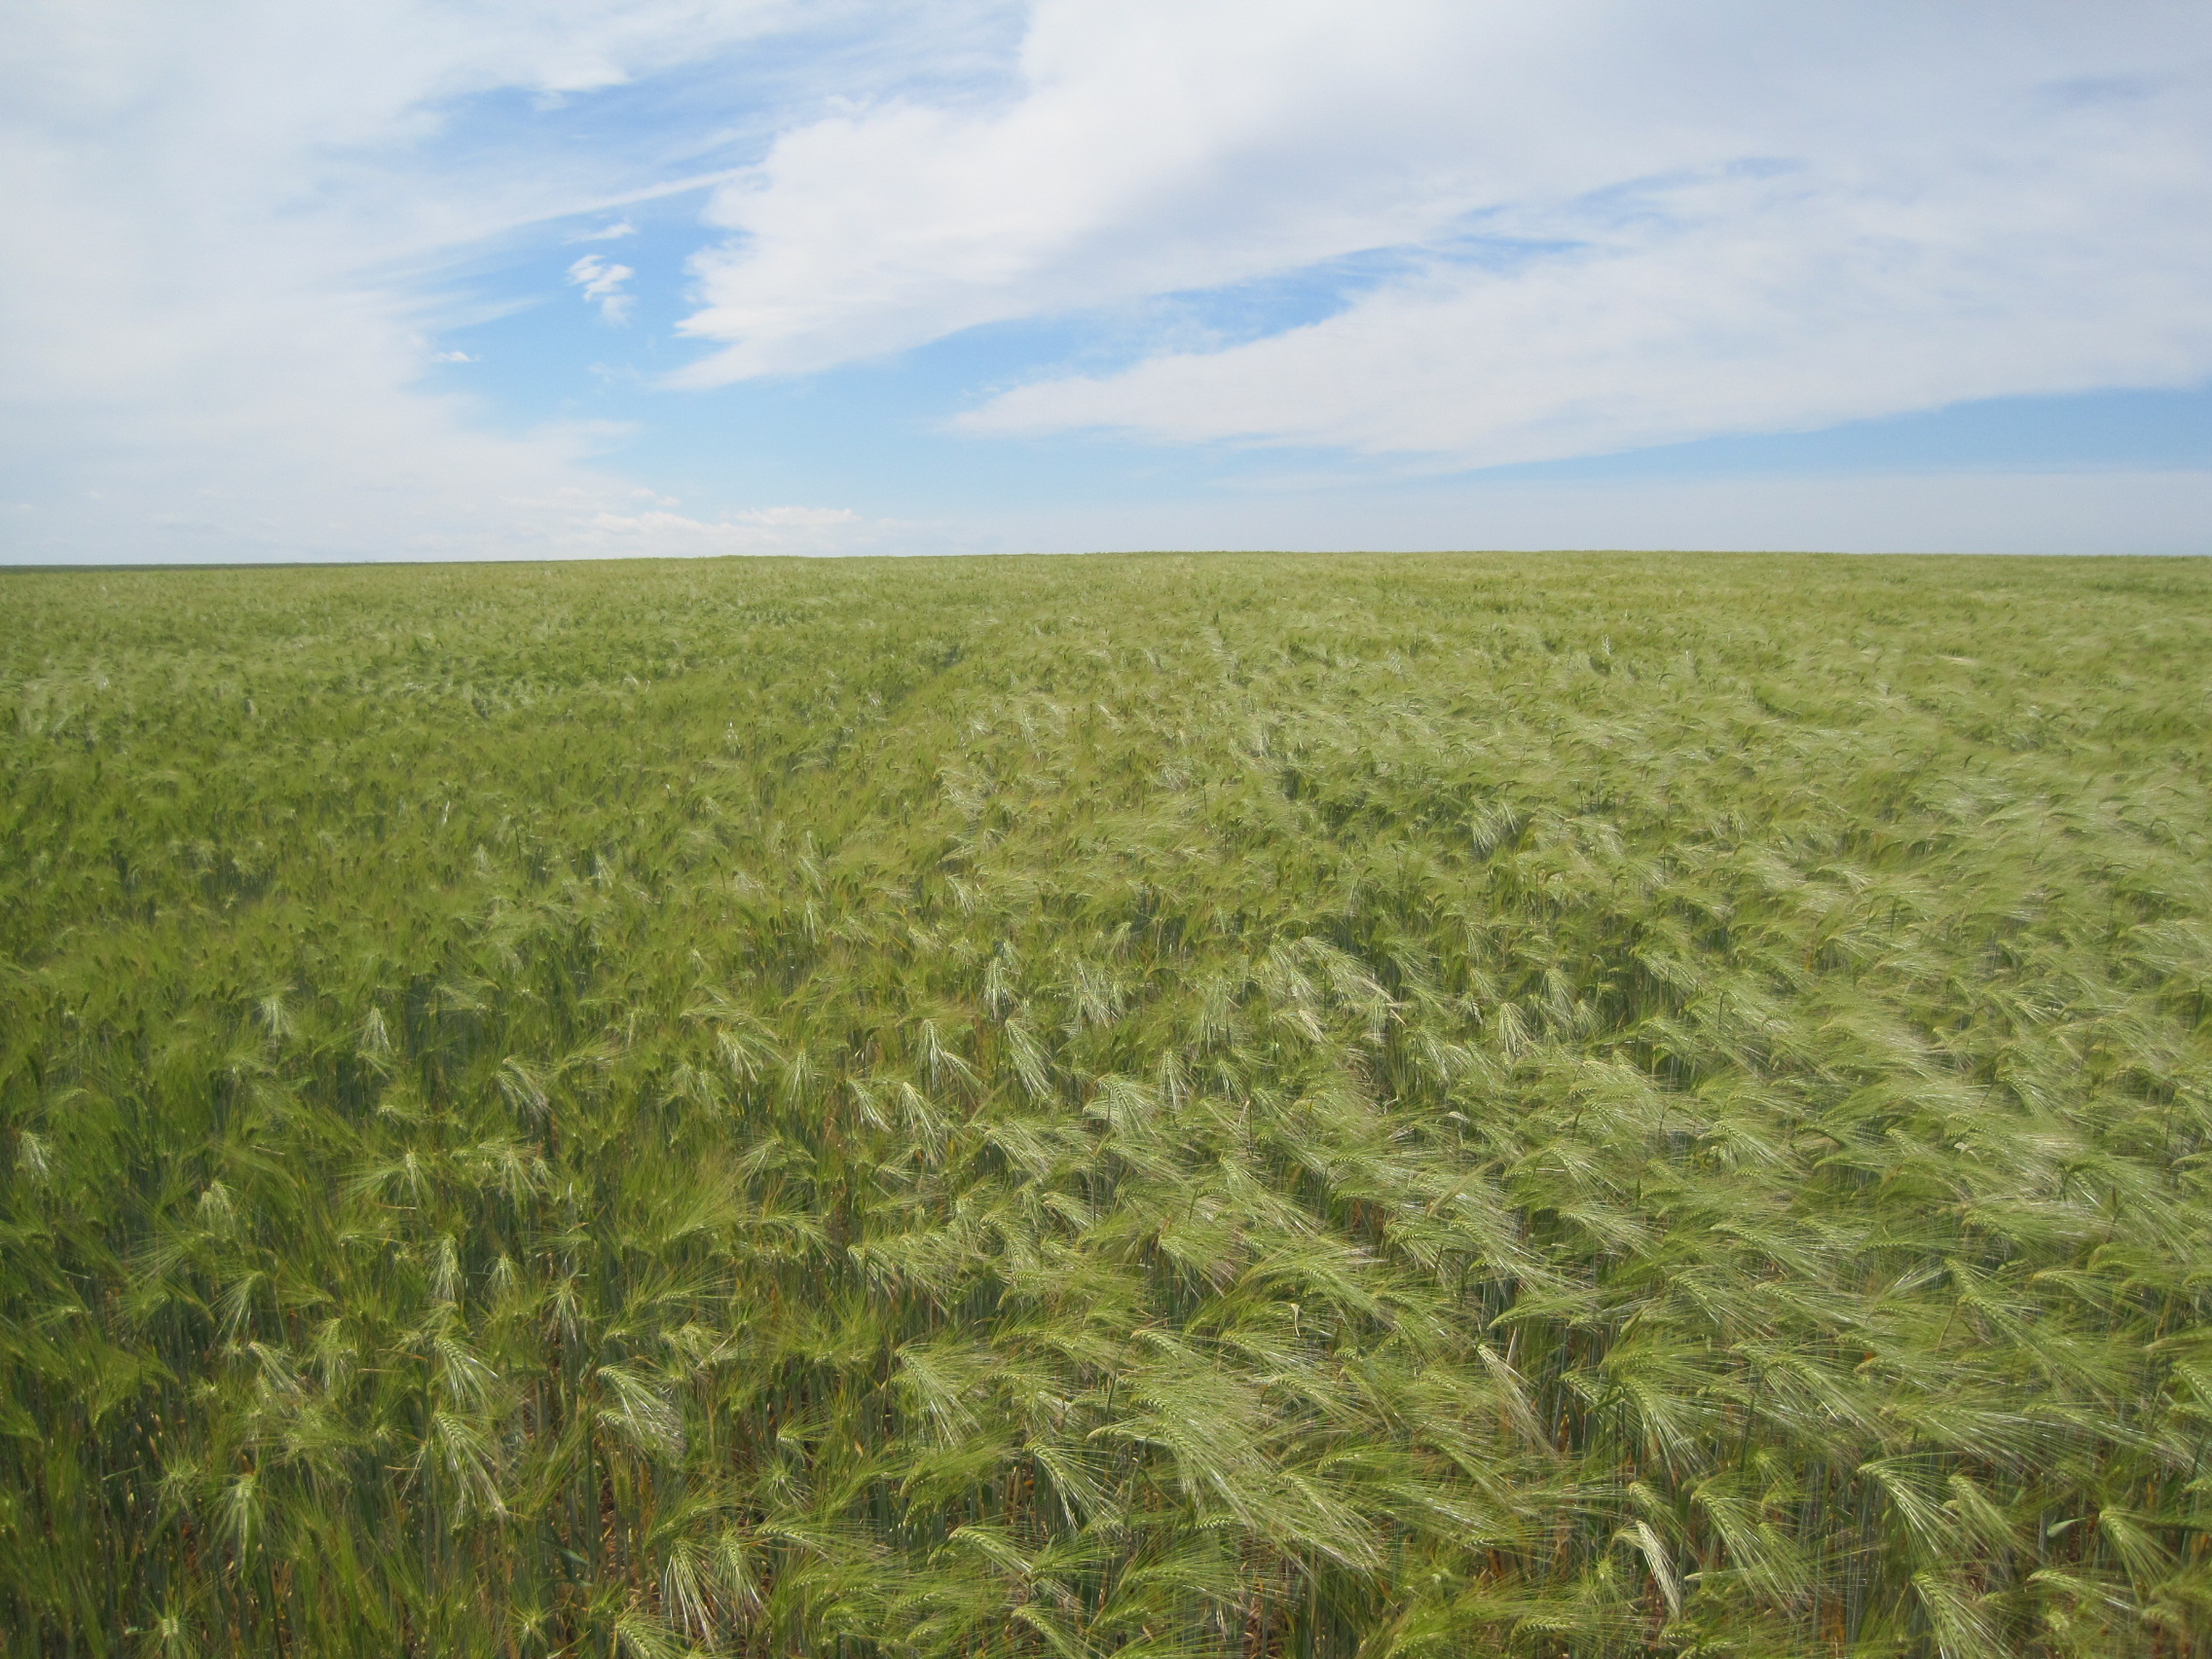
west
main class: Cropland
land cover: Barley
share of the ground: > 75 %
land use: Agriculture (excluding fallow land and kitchen gardens)
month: May
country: ES
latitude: 41.7133
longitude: -5.3577
